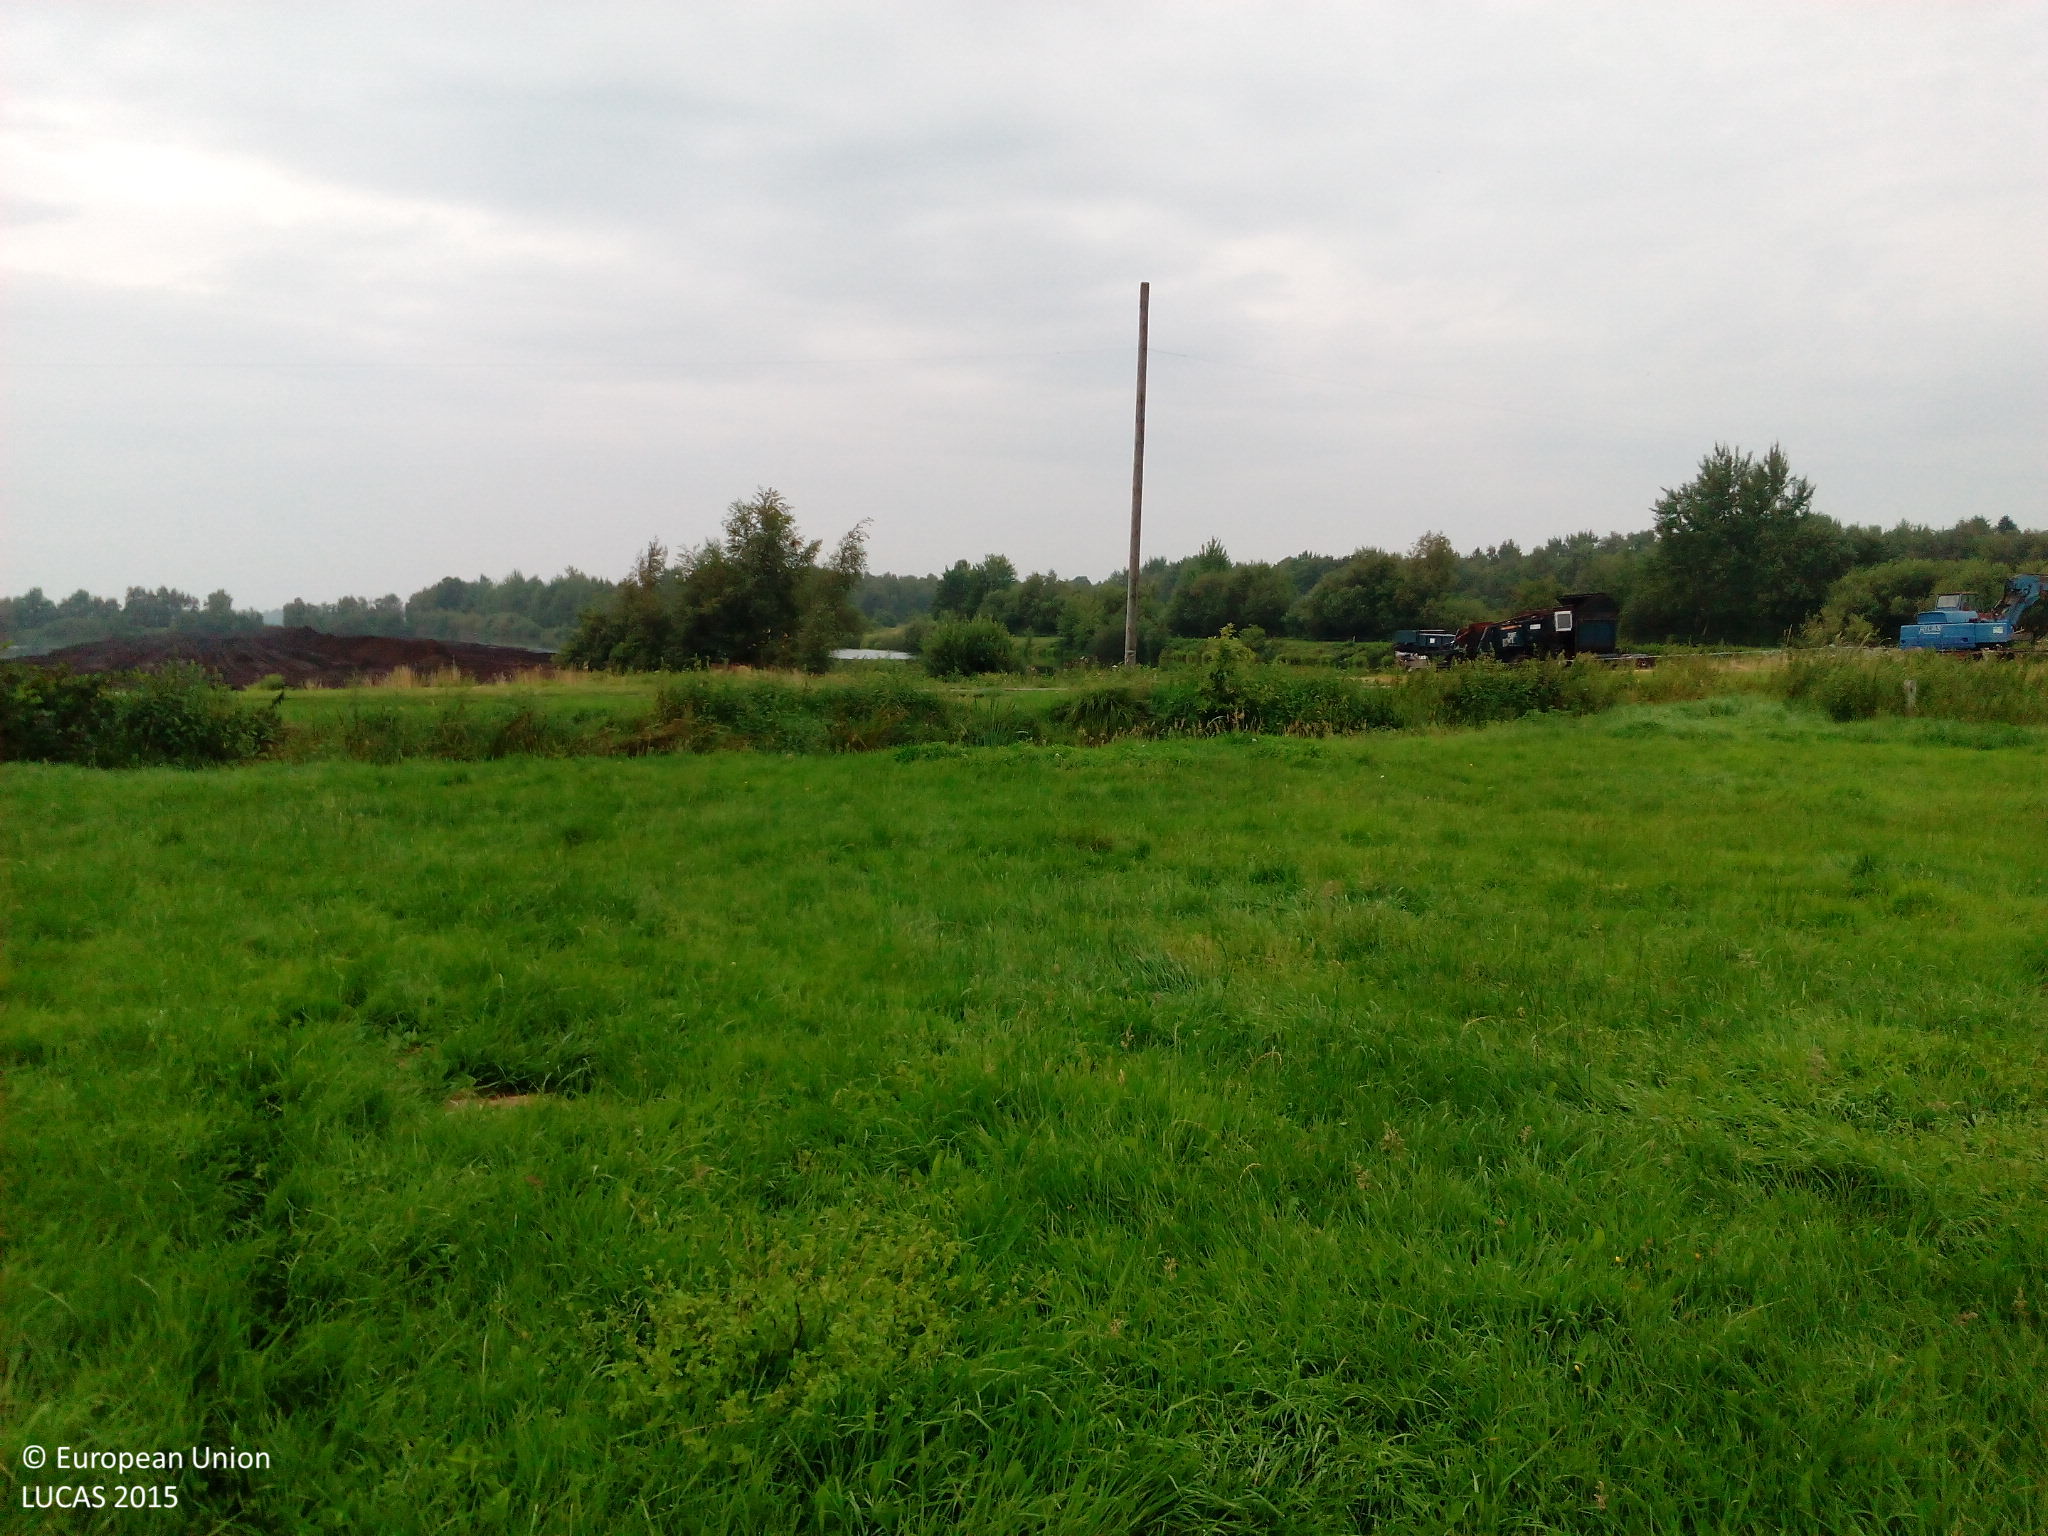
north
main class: Grassland
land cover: Grassland without tree/shrub cover
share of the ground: > 75 %
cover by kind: herbaceous plants 100 %
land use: Agriculture (excluding fallow land and kitchen gardens)
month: August
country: DE
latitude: 53.8687
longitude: 9.6504
